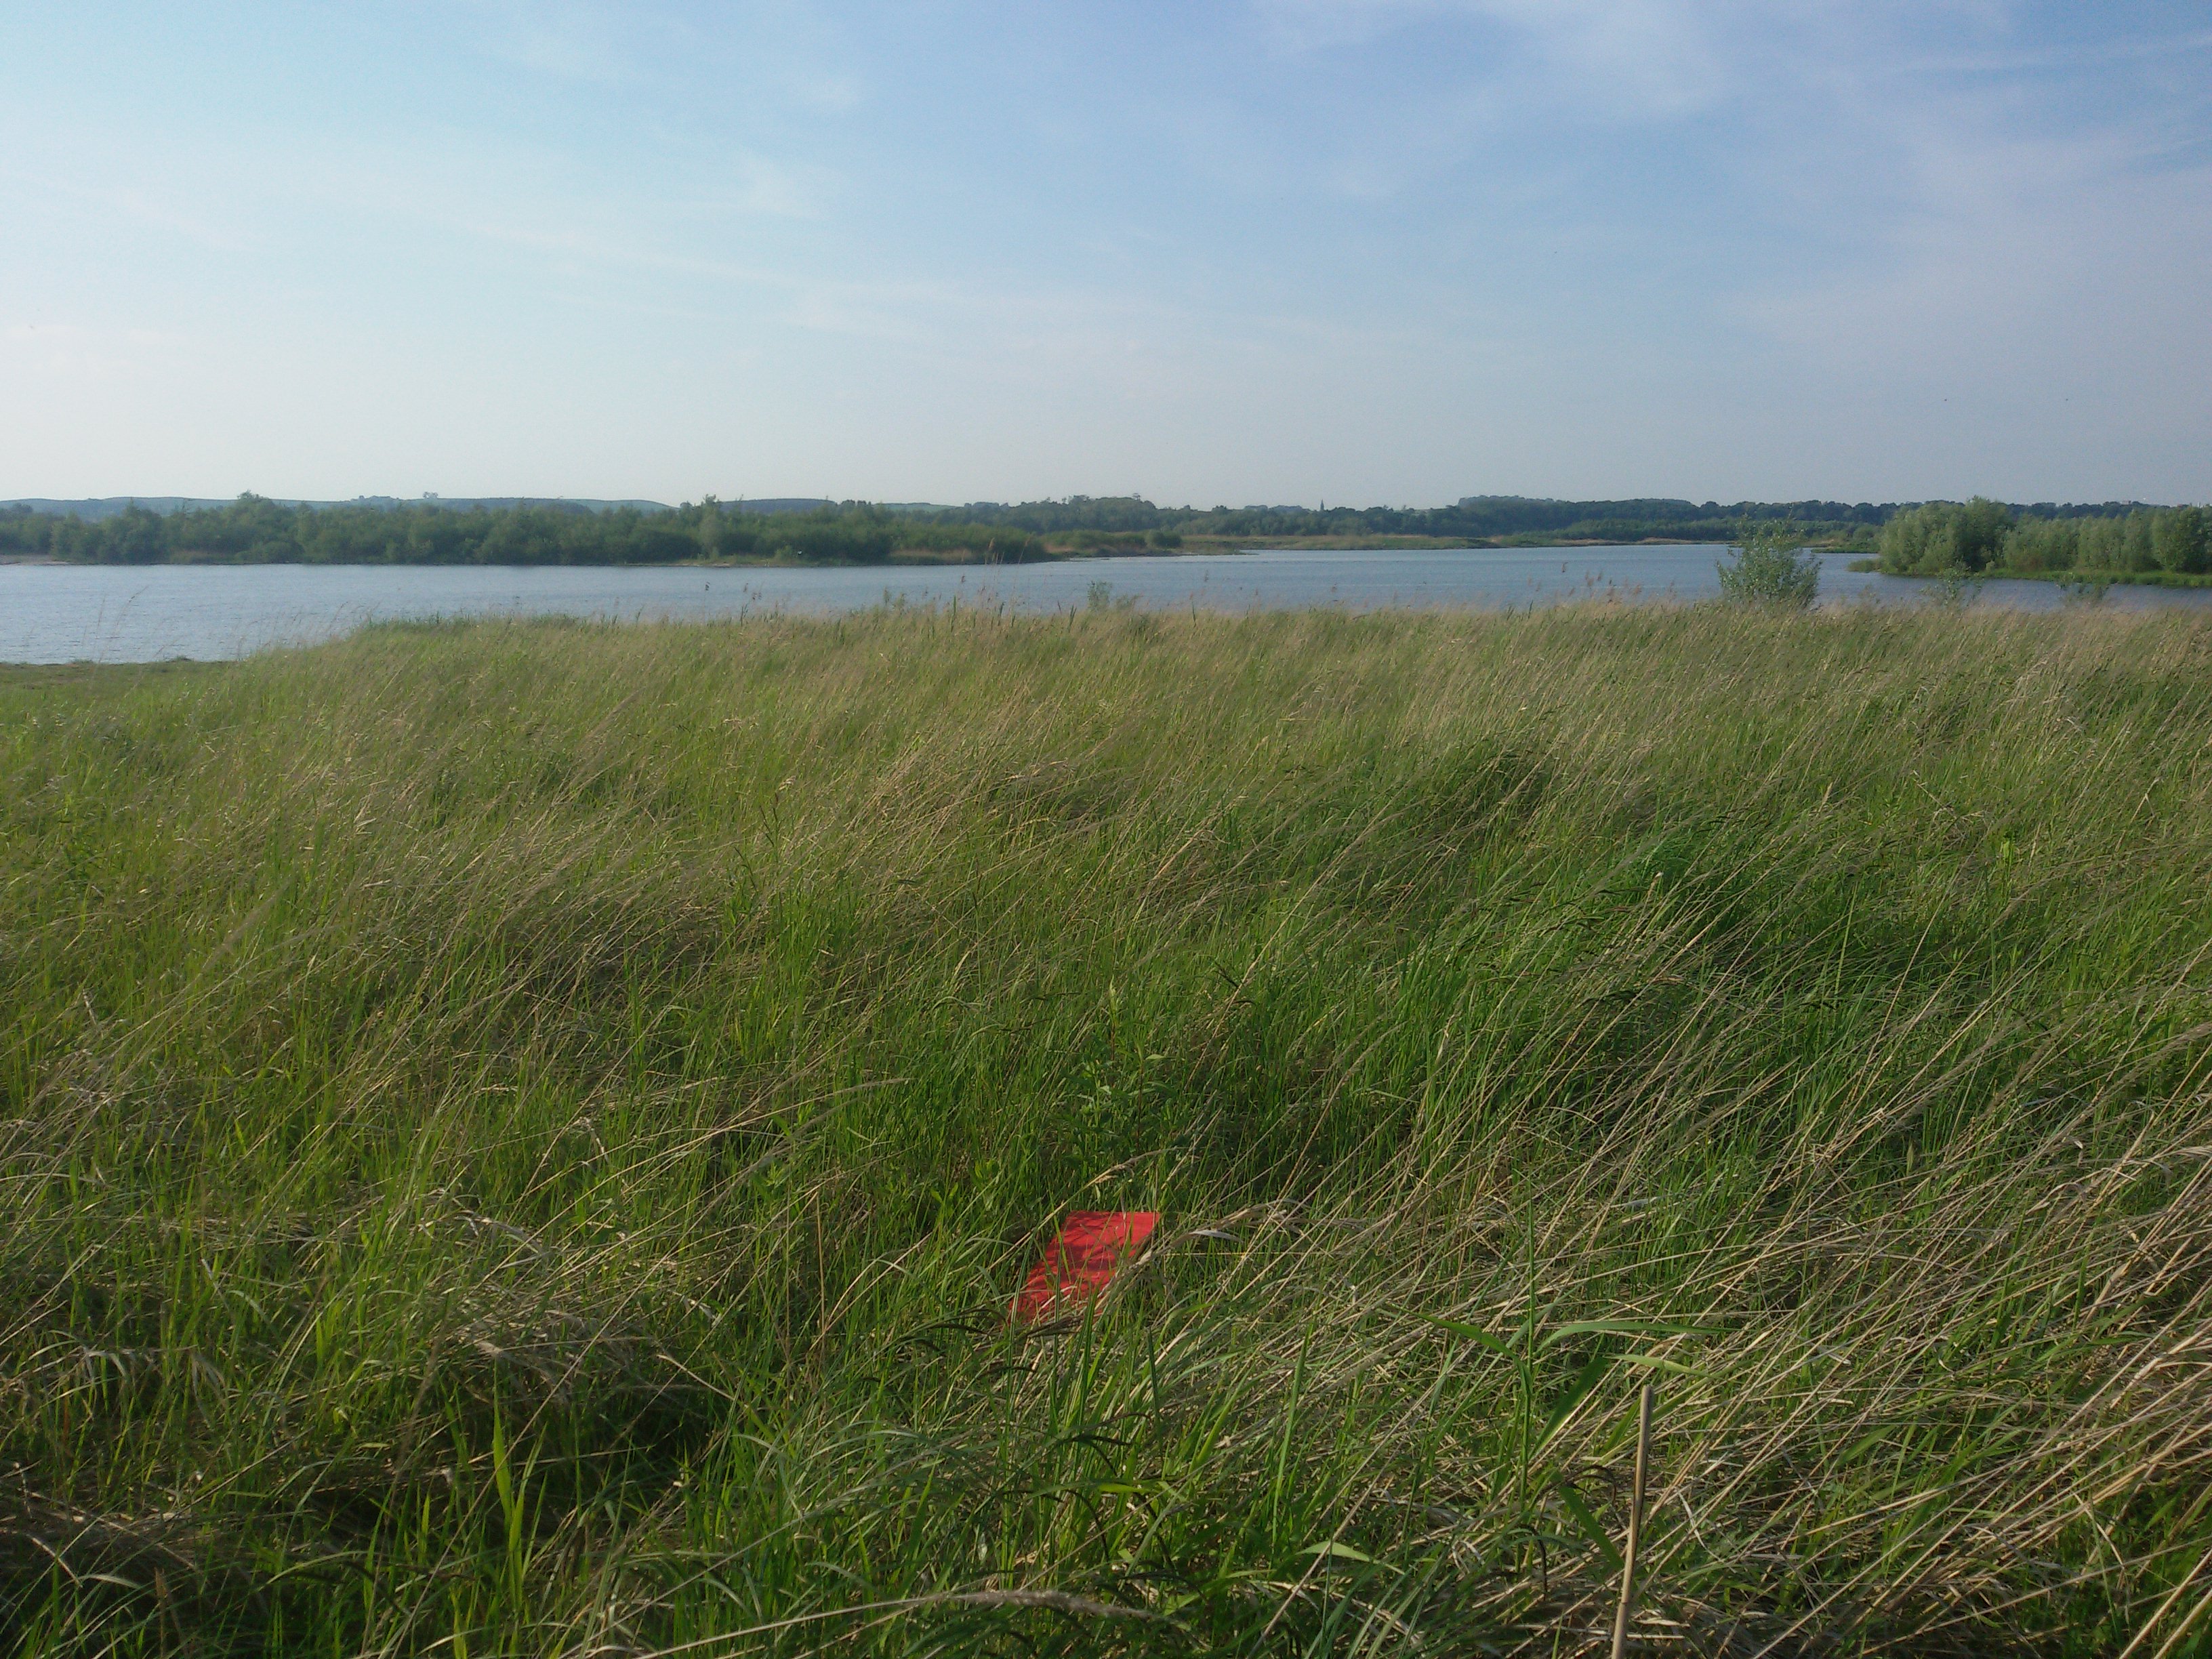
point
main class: Grassland
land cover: Grassland without tree/shrub cover
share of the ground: > 75 %
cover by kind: herbaceous plants 85 %
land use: Semi-natural and natural areas not in use
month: May
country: PL
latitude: 50.4418
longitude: 17.2347
